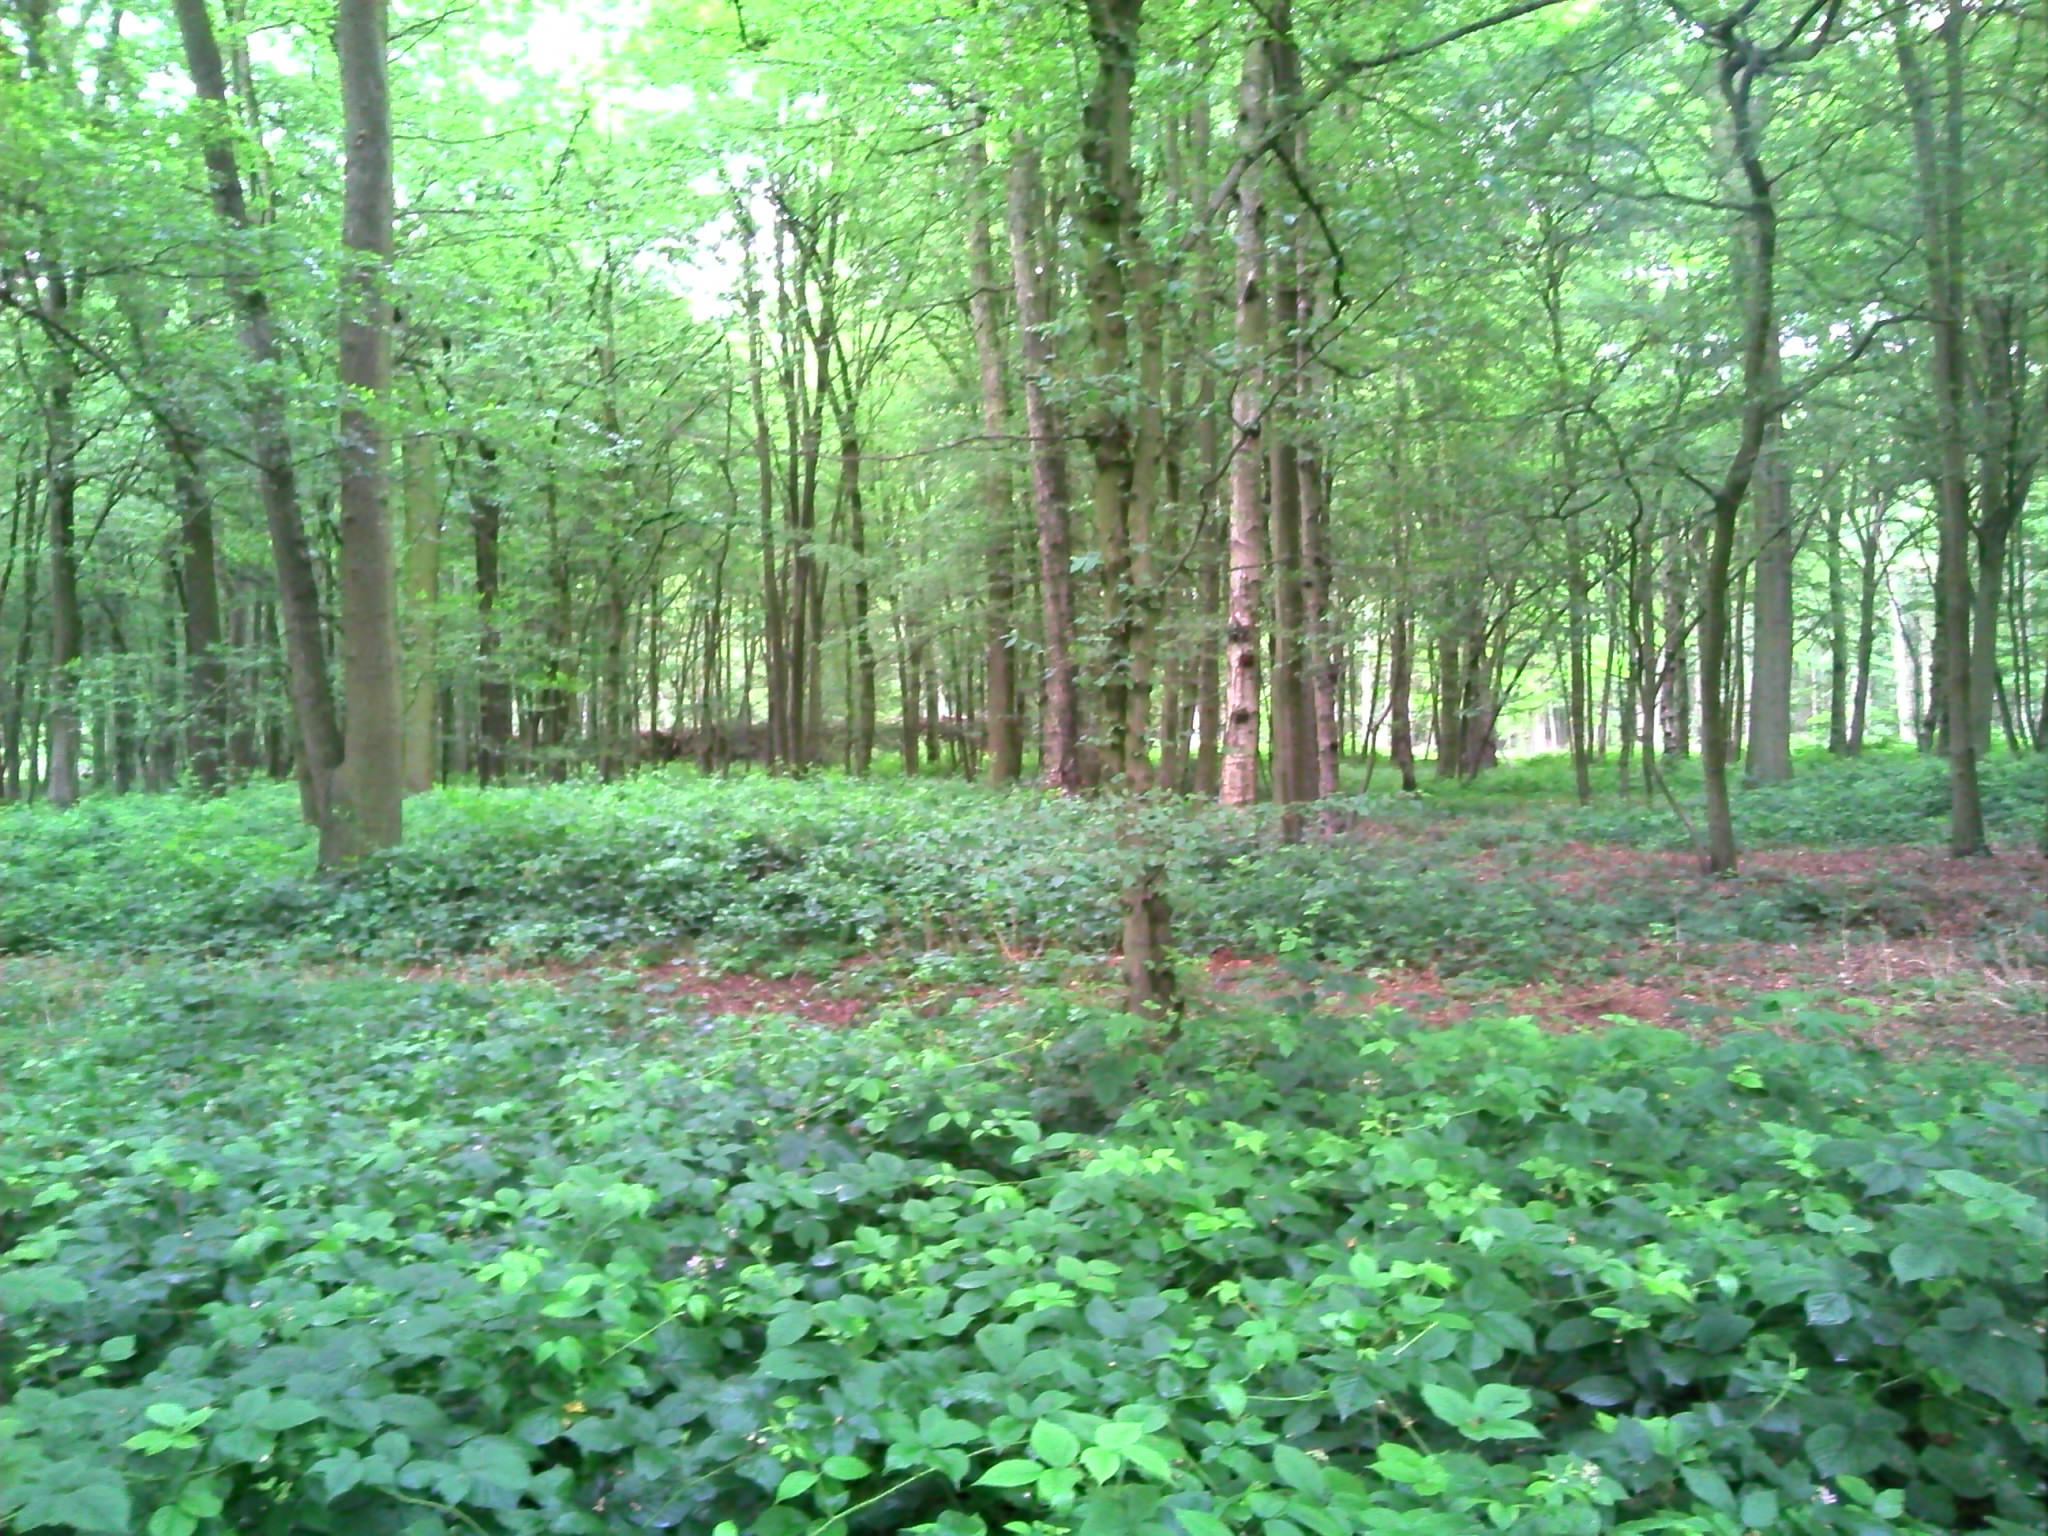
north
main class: Woodland
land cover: Broadleaved woodland
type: acidophilous oak and oak-birch forest
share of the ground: > 75 %
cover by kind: broadleaved forest trees 80 %, herbaceous plants 15 %, lichens and mosses 5 %
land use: Forestry
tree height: > 5 m
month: July
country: FR
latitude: 50.4966
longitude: 3.0686
